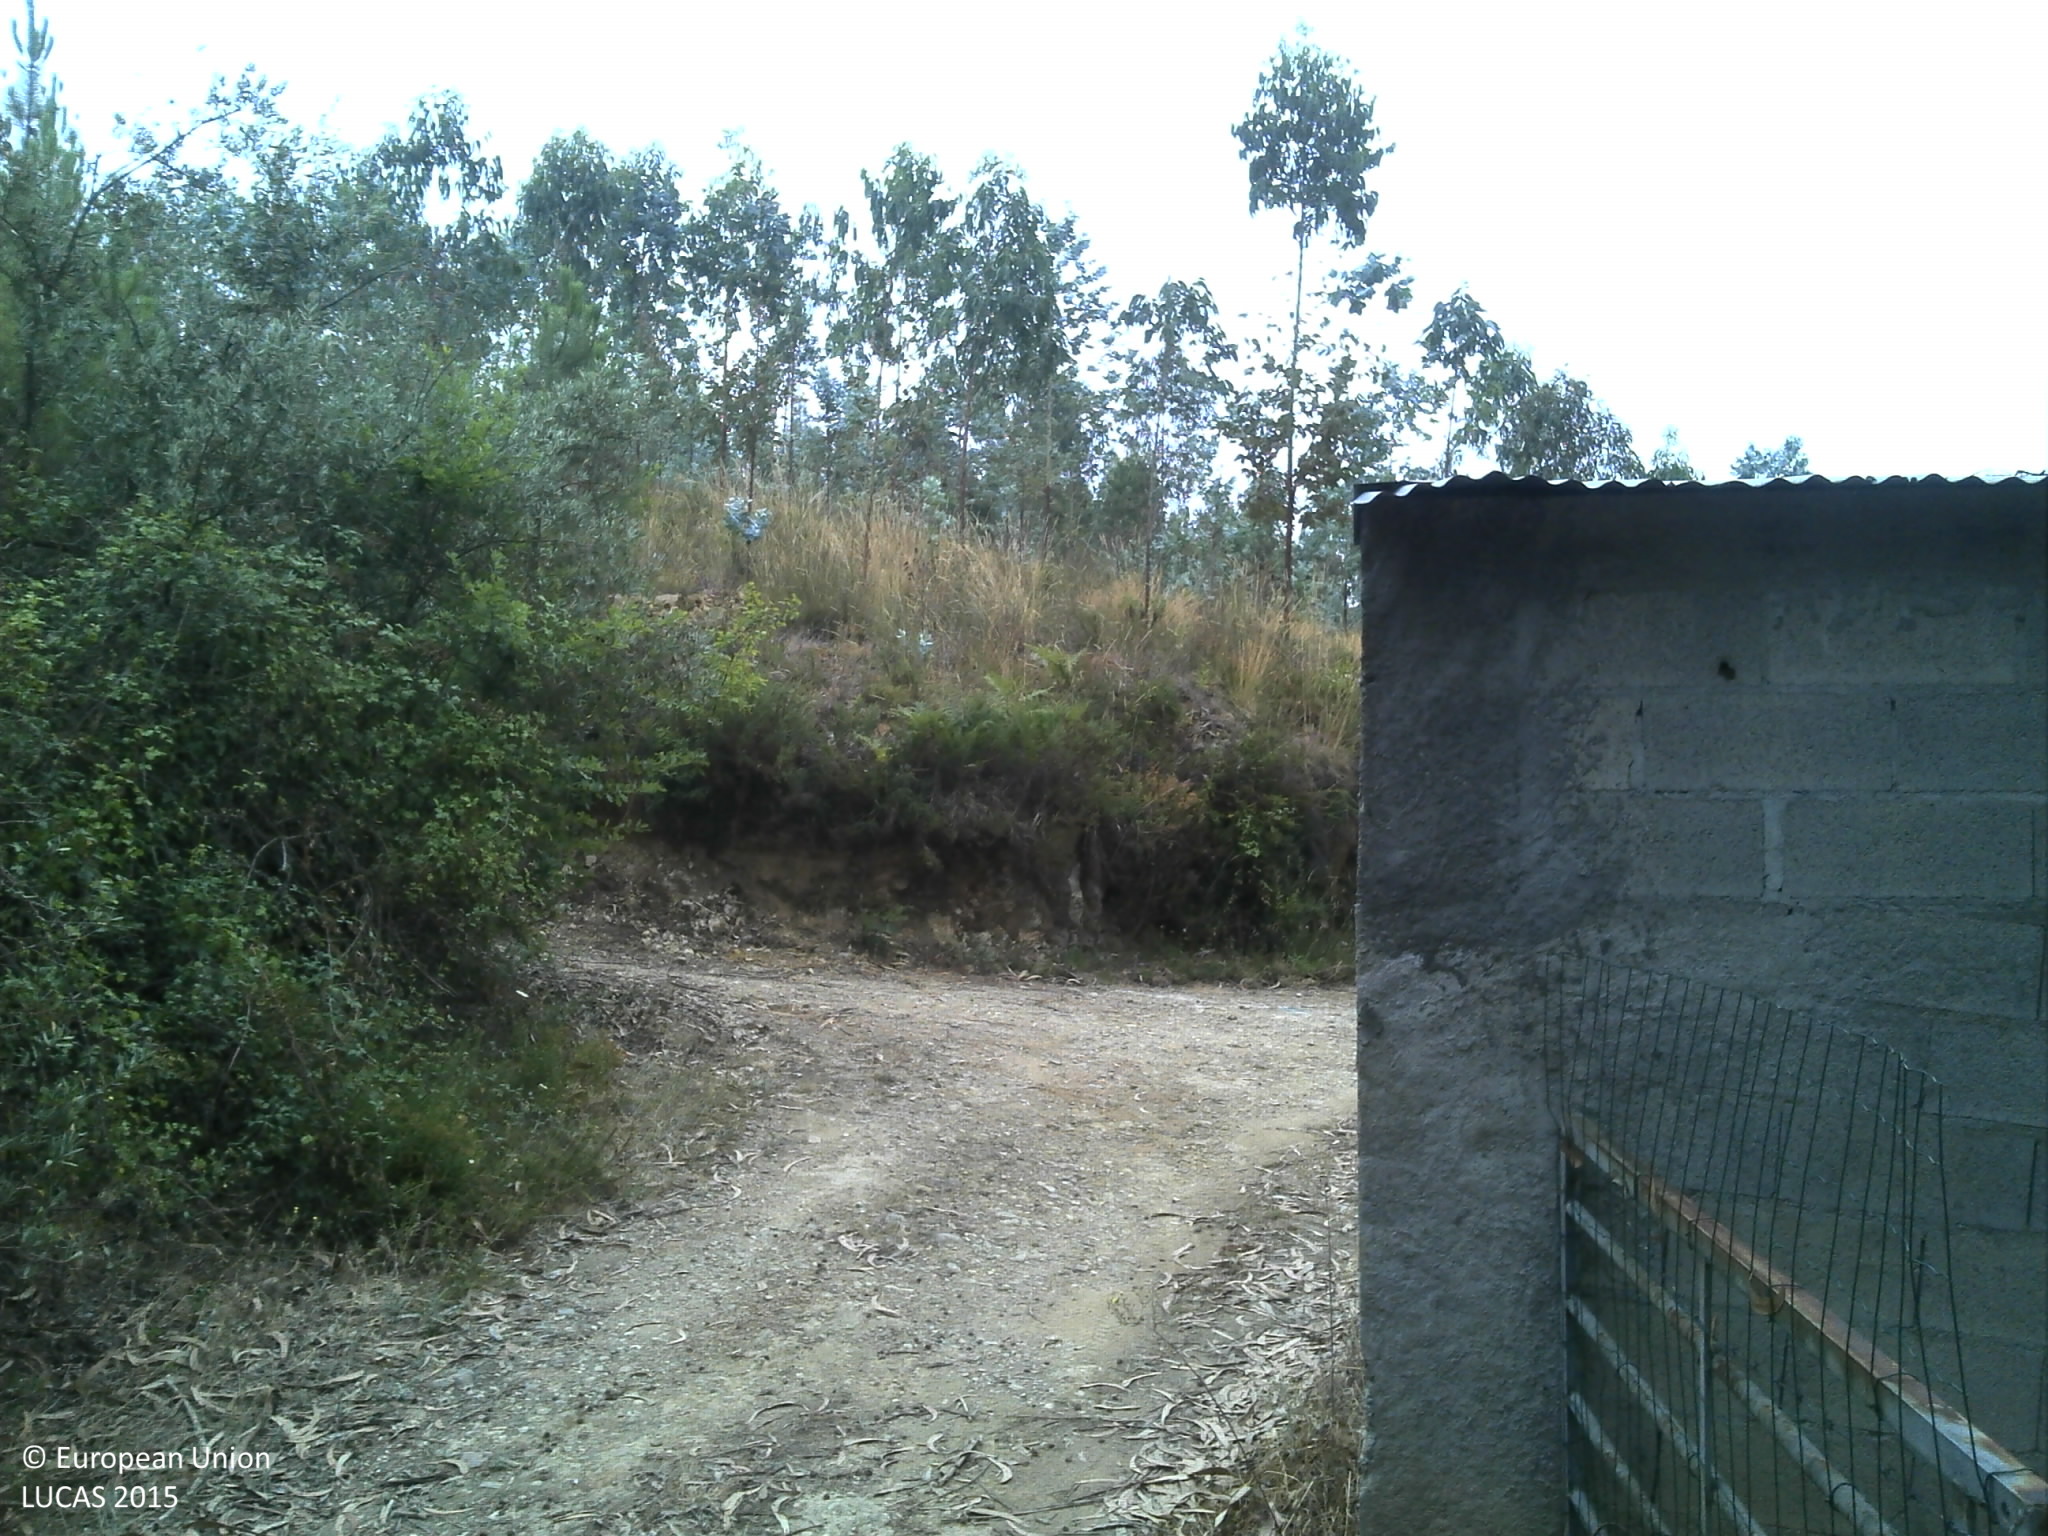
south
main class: Woodland
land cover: Broadleaved woodland
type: exotic forest
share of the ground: 50 - 75 %
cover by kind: broadleaved forest trees 70 %, shrubs 20 %, herbaceous plants 5 %, unconsolidated bare surface 5 %
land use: Forestry
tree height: > 5 m
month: July
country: PT
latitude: 40.3120
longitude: -8.2607
